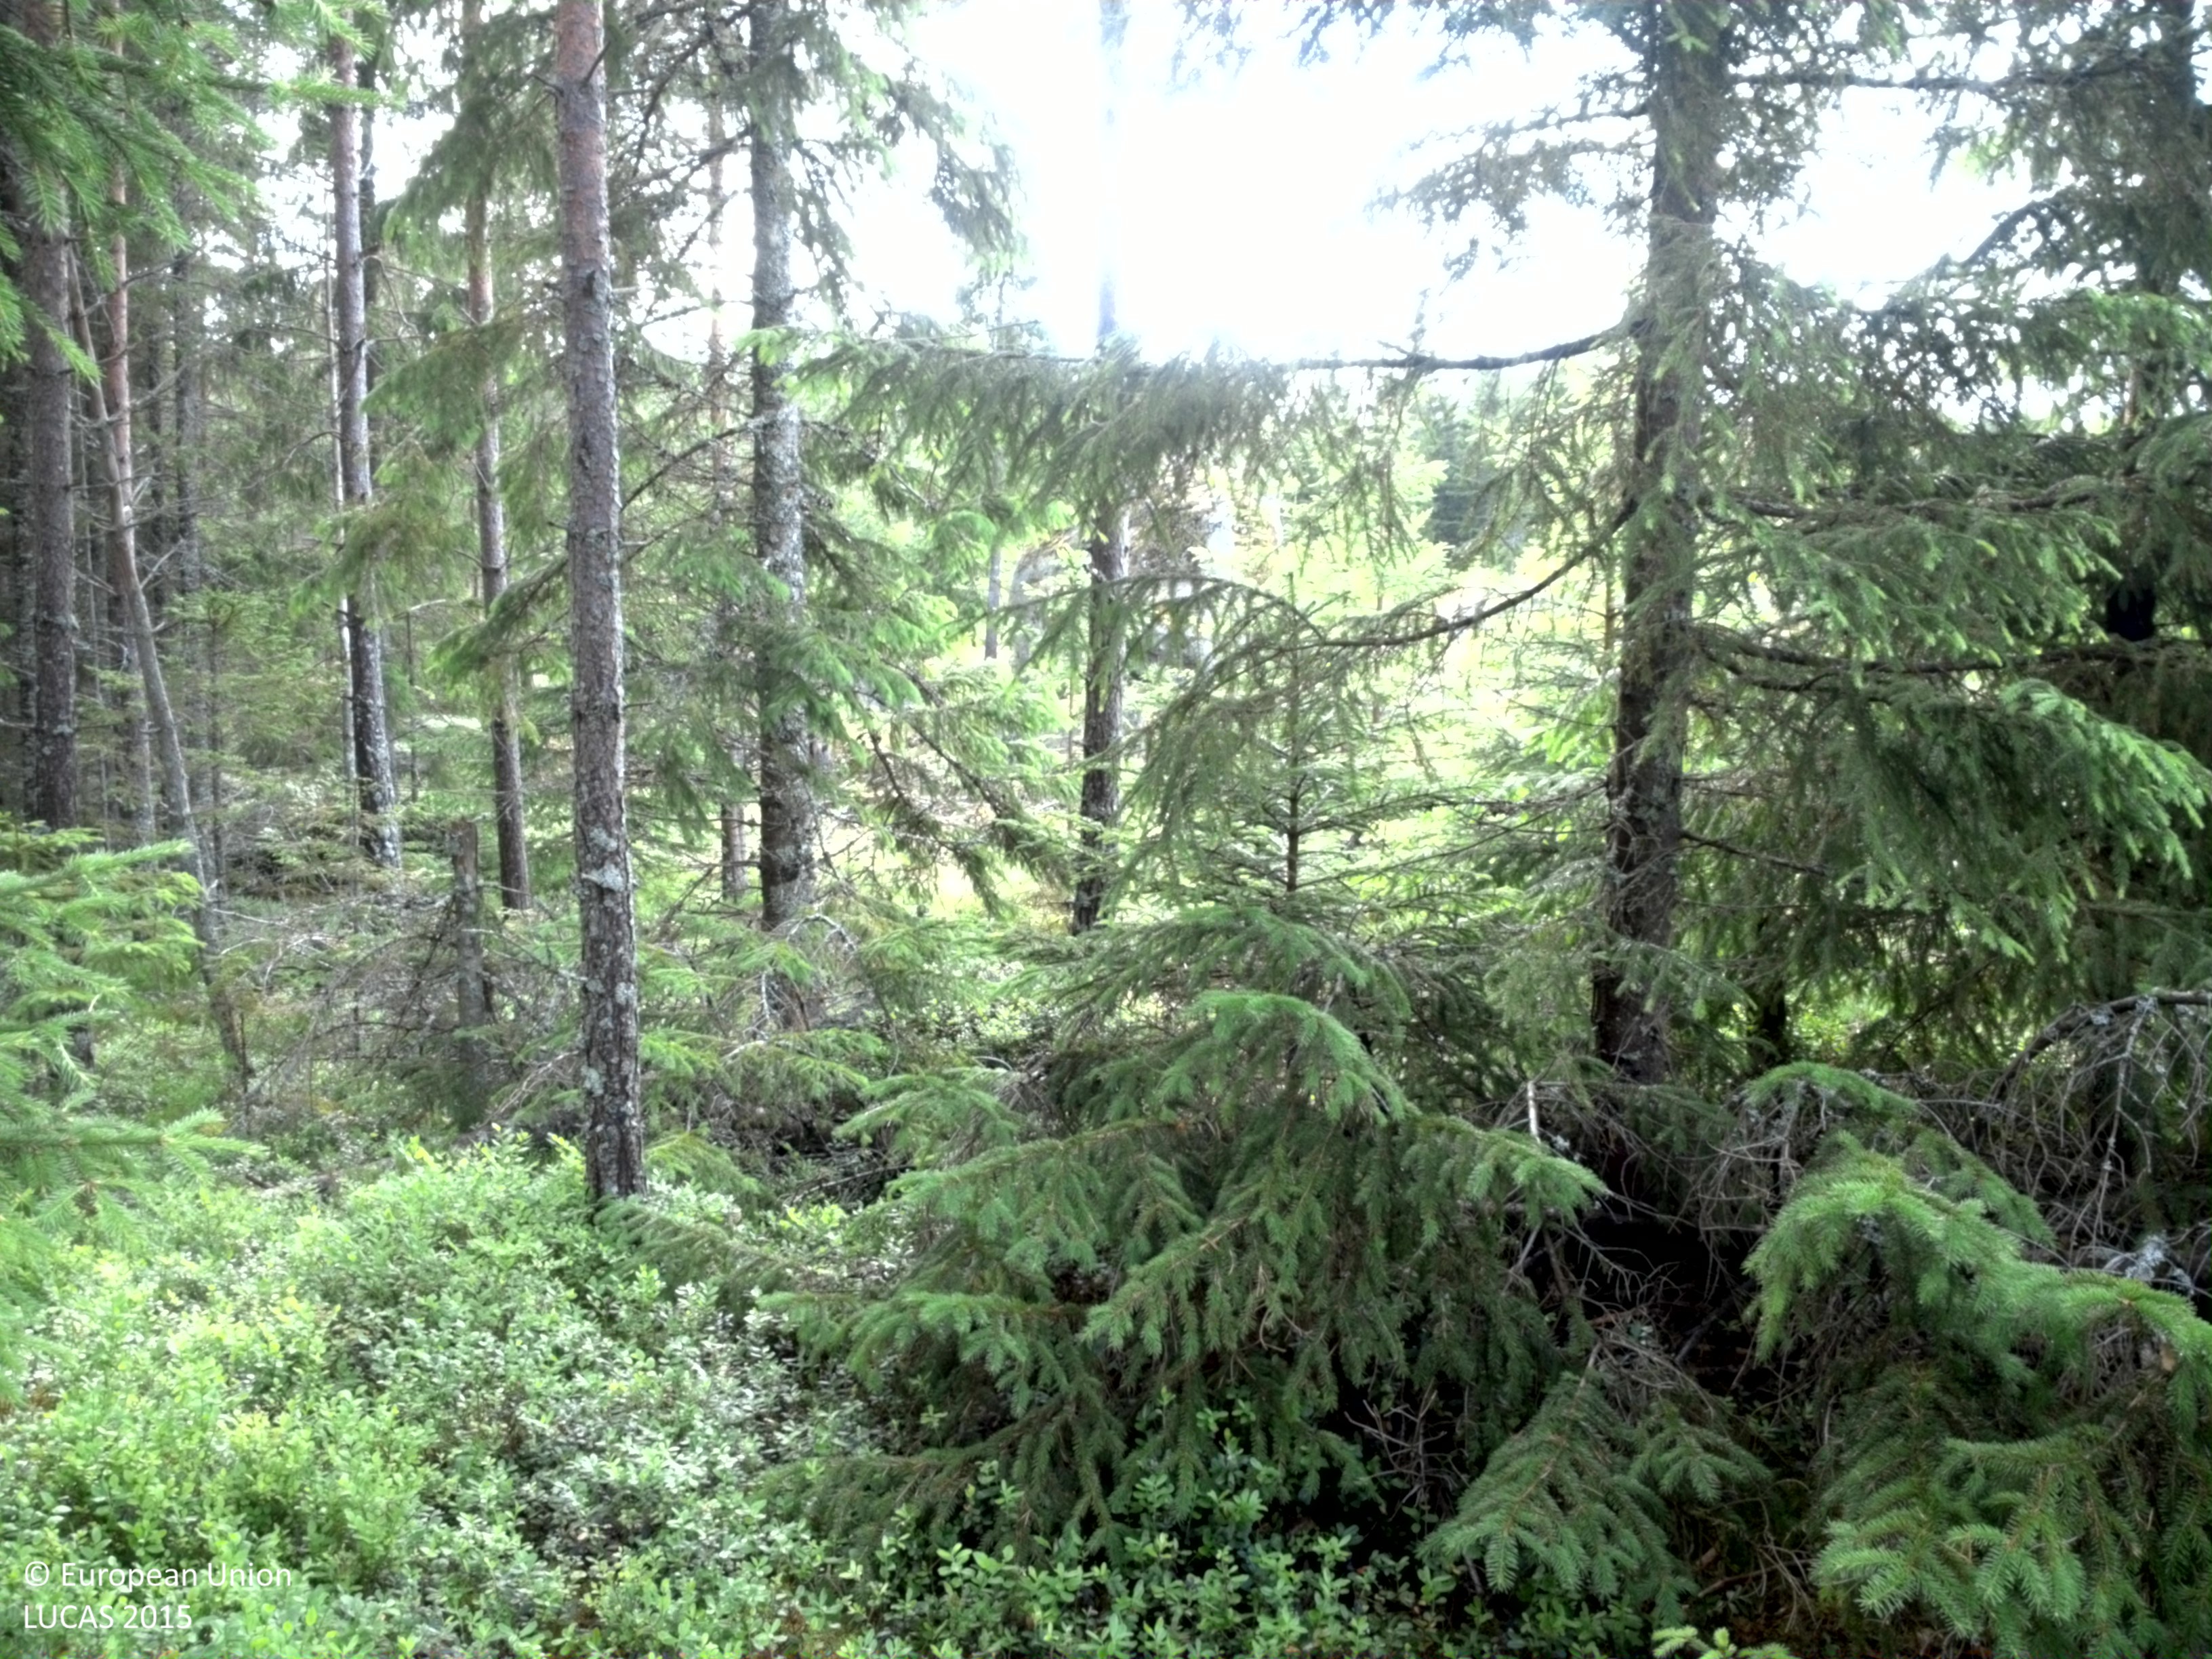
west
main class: Woodland
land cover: Pine dominated coniferous woodland
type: boreal forest
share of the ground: > 75 %
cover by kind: coniferous forest trees 70 %, shrubs 20 %, broadleaved forest trees 10 %
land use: Forestry
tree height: > 5 m
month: July
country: SE
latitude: 59.4544
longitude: 14.6658
